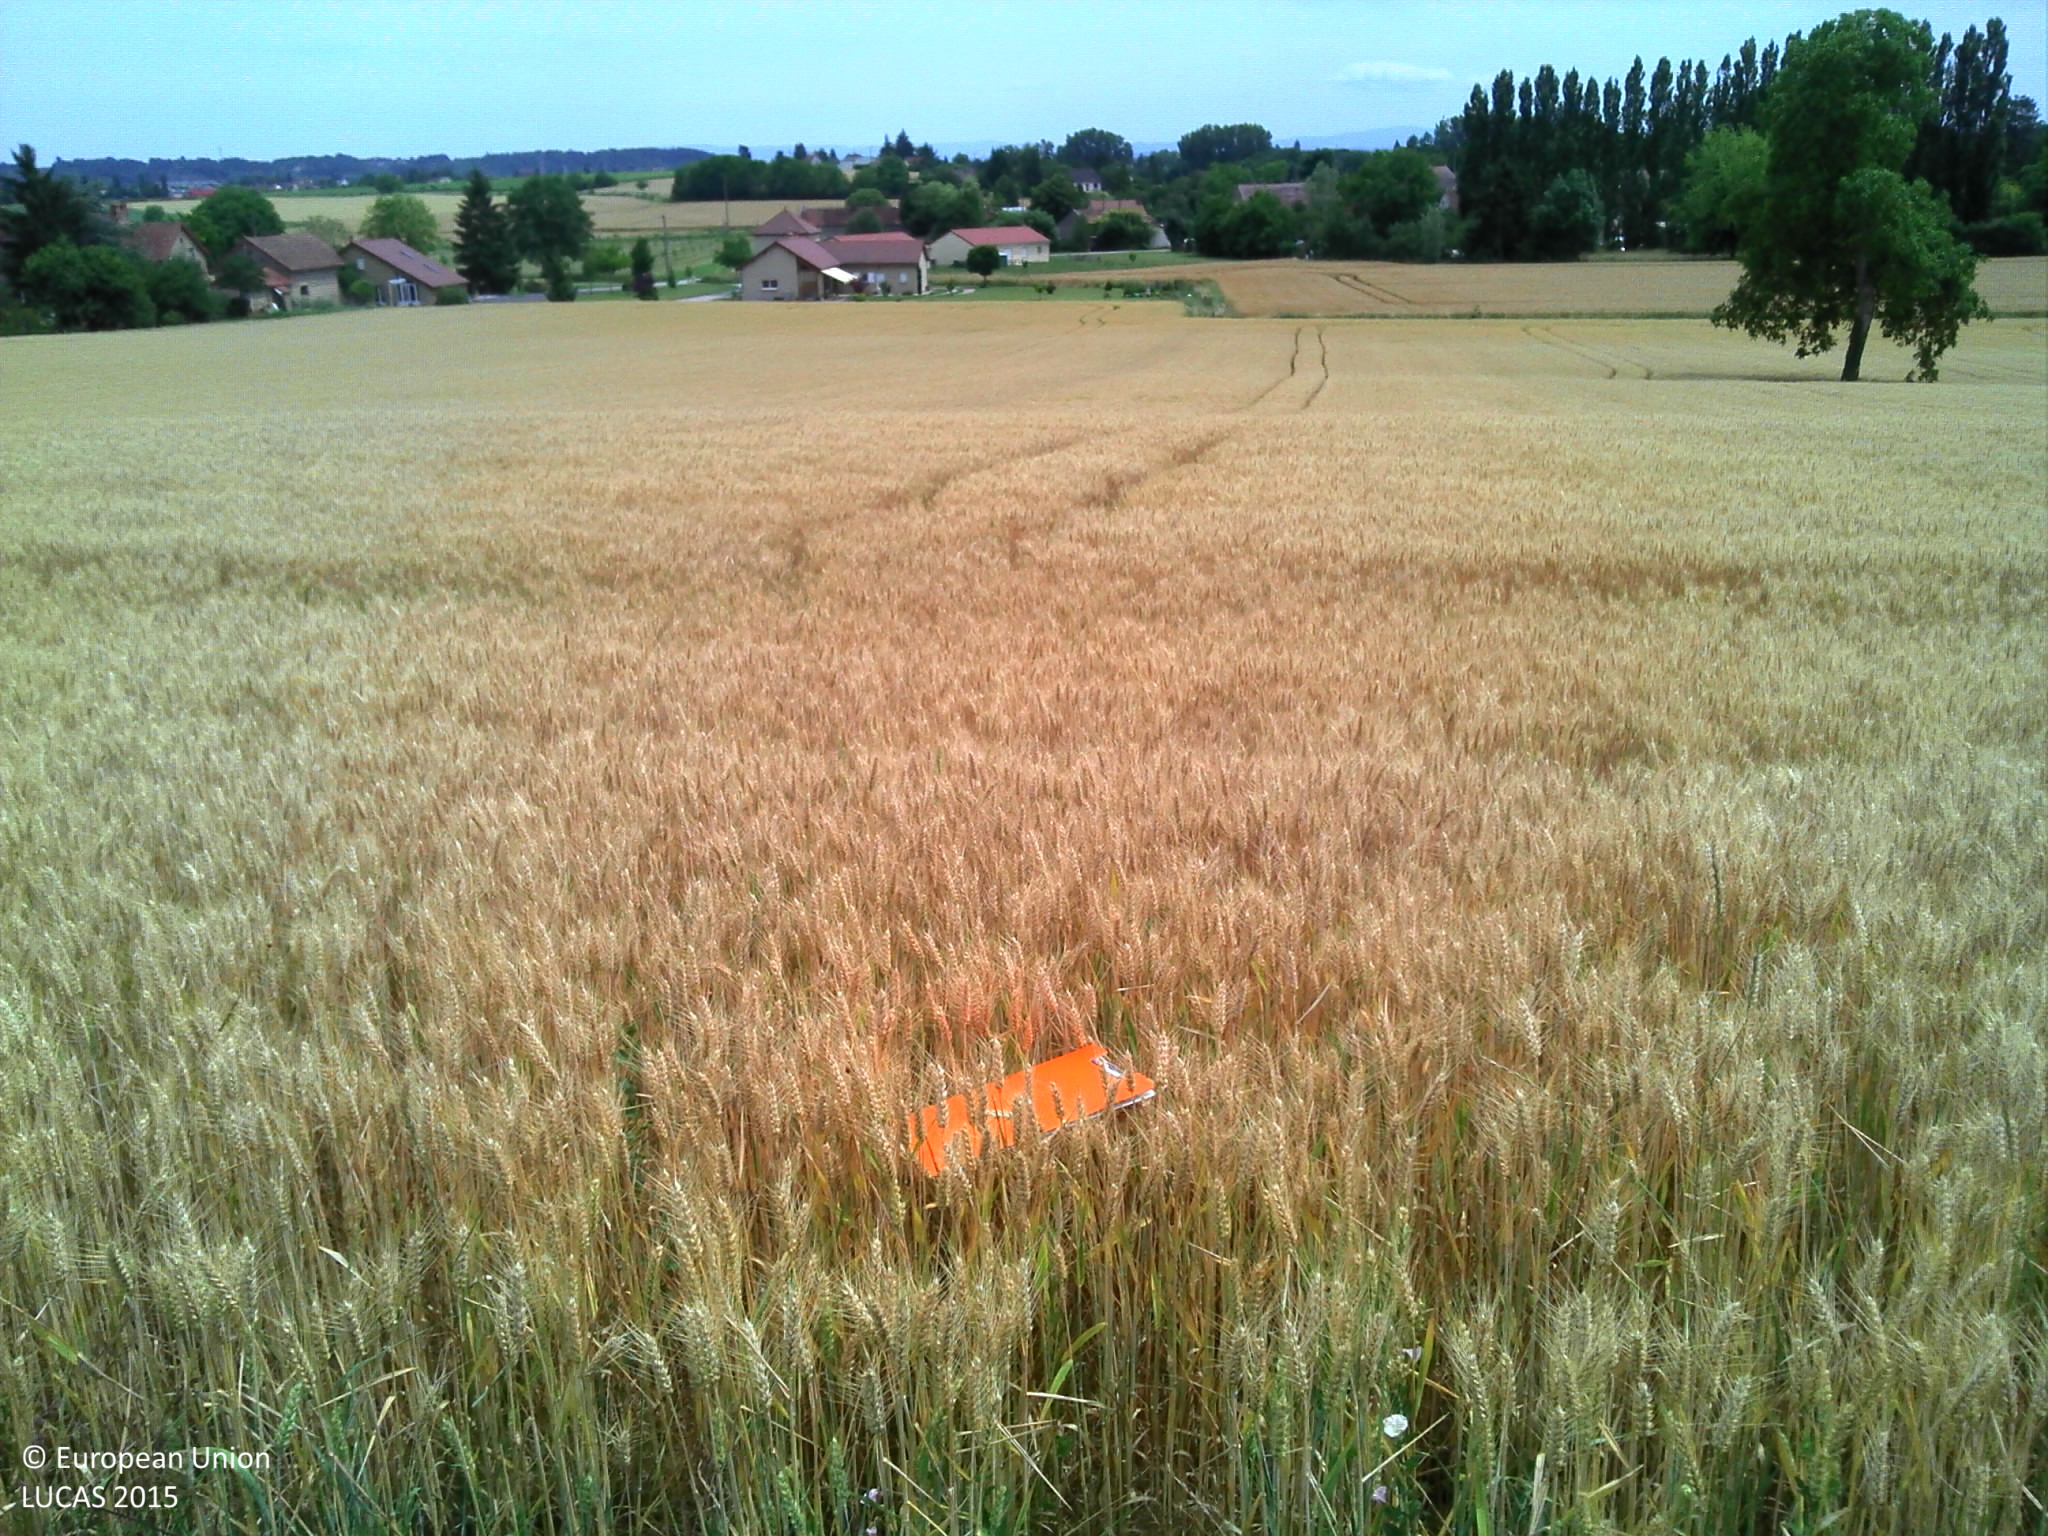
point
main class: Cropland
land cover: Common wheat
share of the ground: > 75 %
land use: Agriculture (excluding fallow land and kitchen gardens)
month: June
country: FR
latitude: 46.3191
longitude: 3.2582
